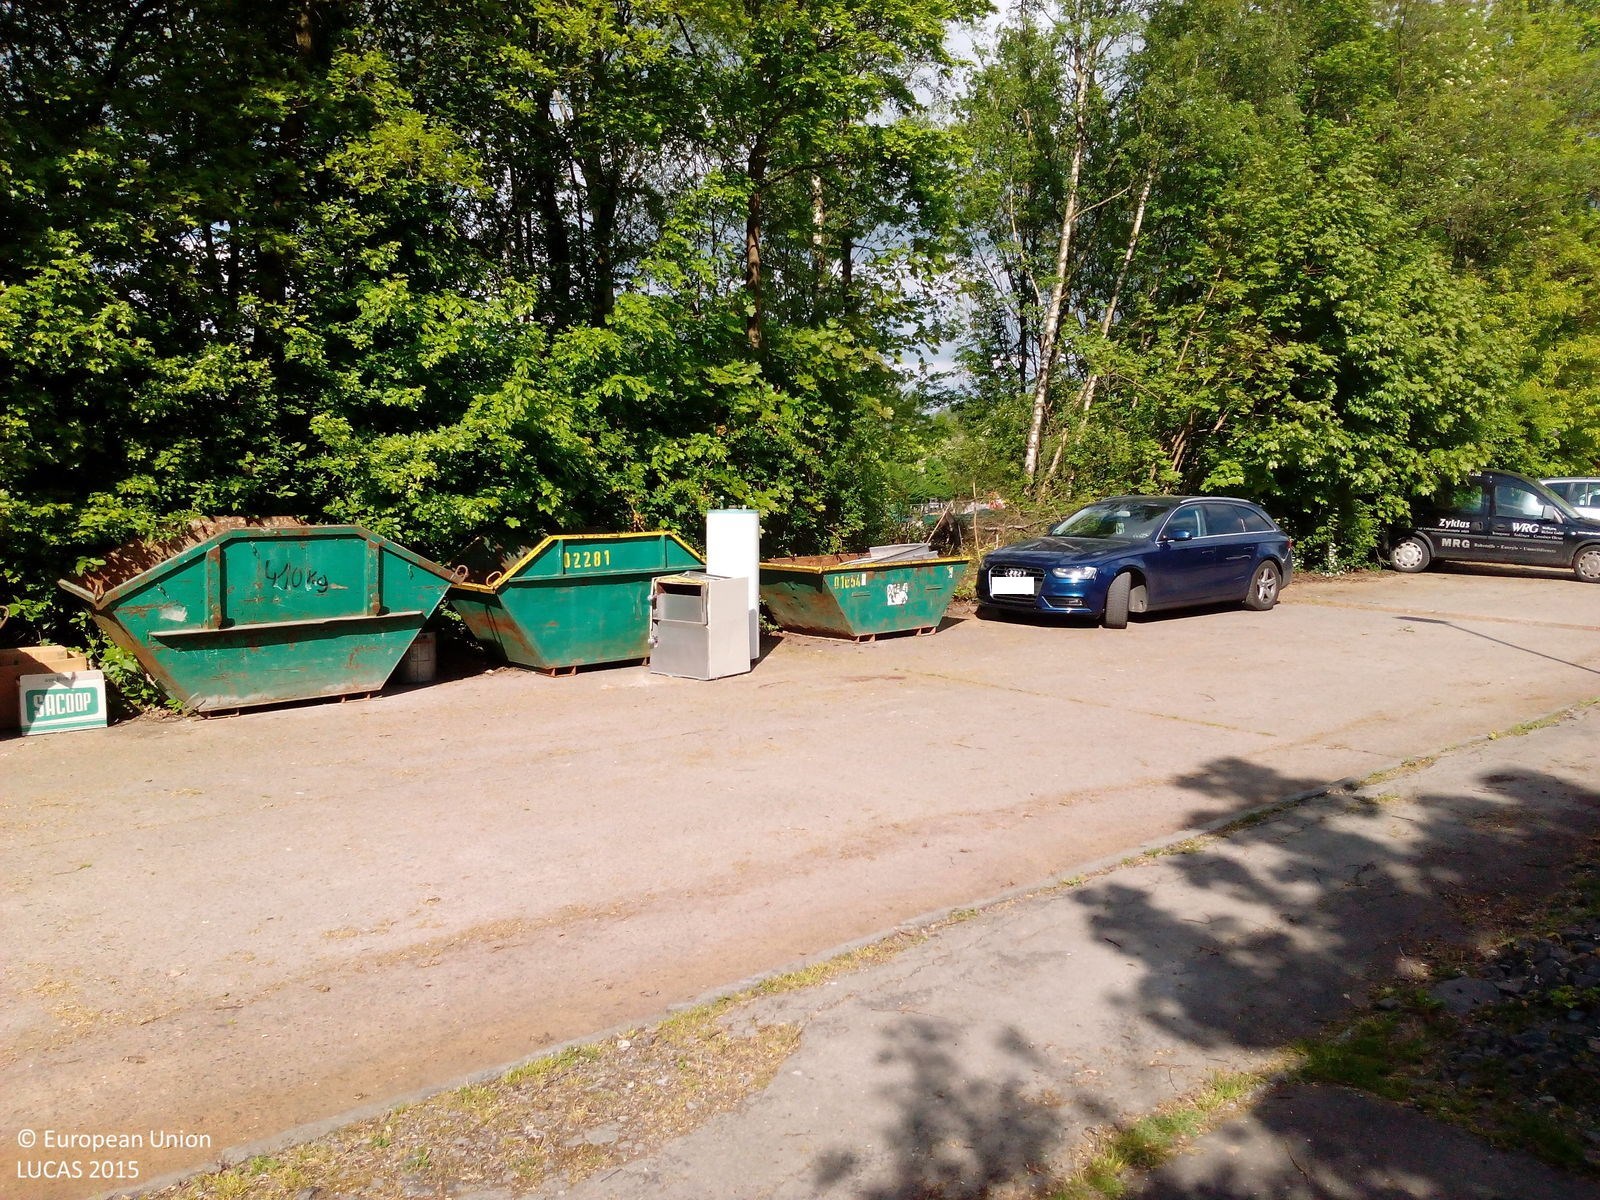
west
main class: Shrubland
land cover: Shrubland without tree cover
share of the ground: > 75 %
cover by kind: shrubs 100 %
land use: Road transport
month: May
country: DE
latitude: 51.8736
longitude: 9.6370
